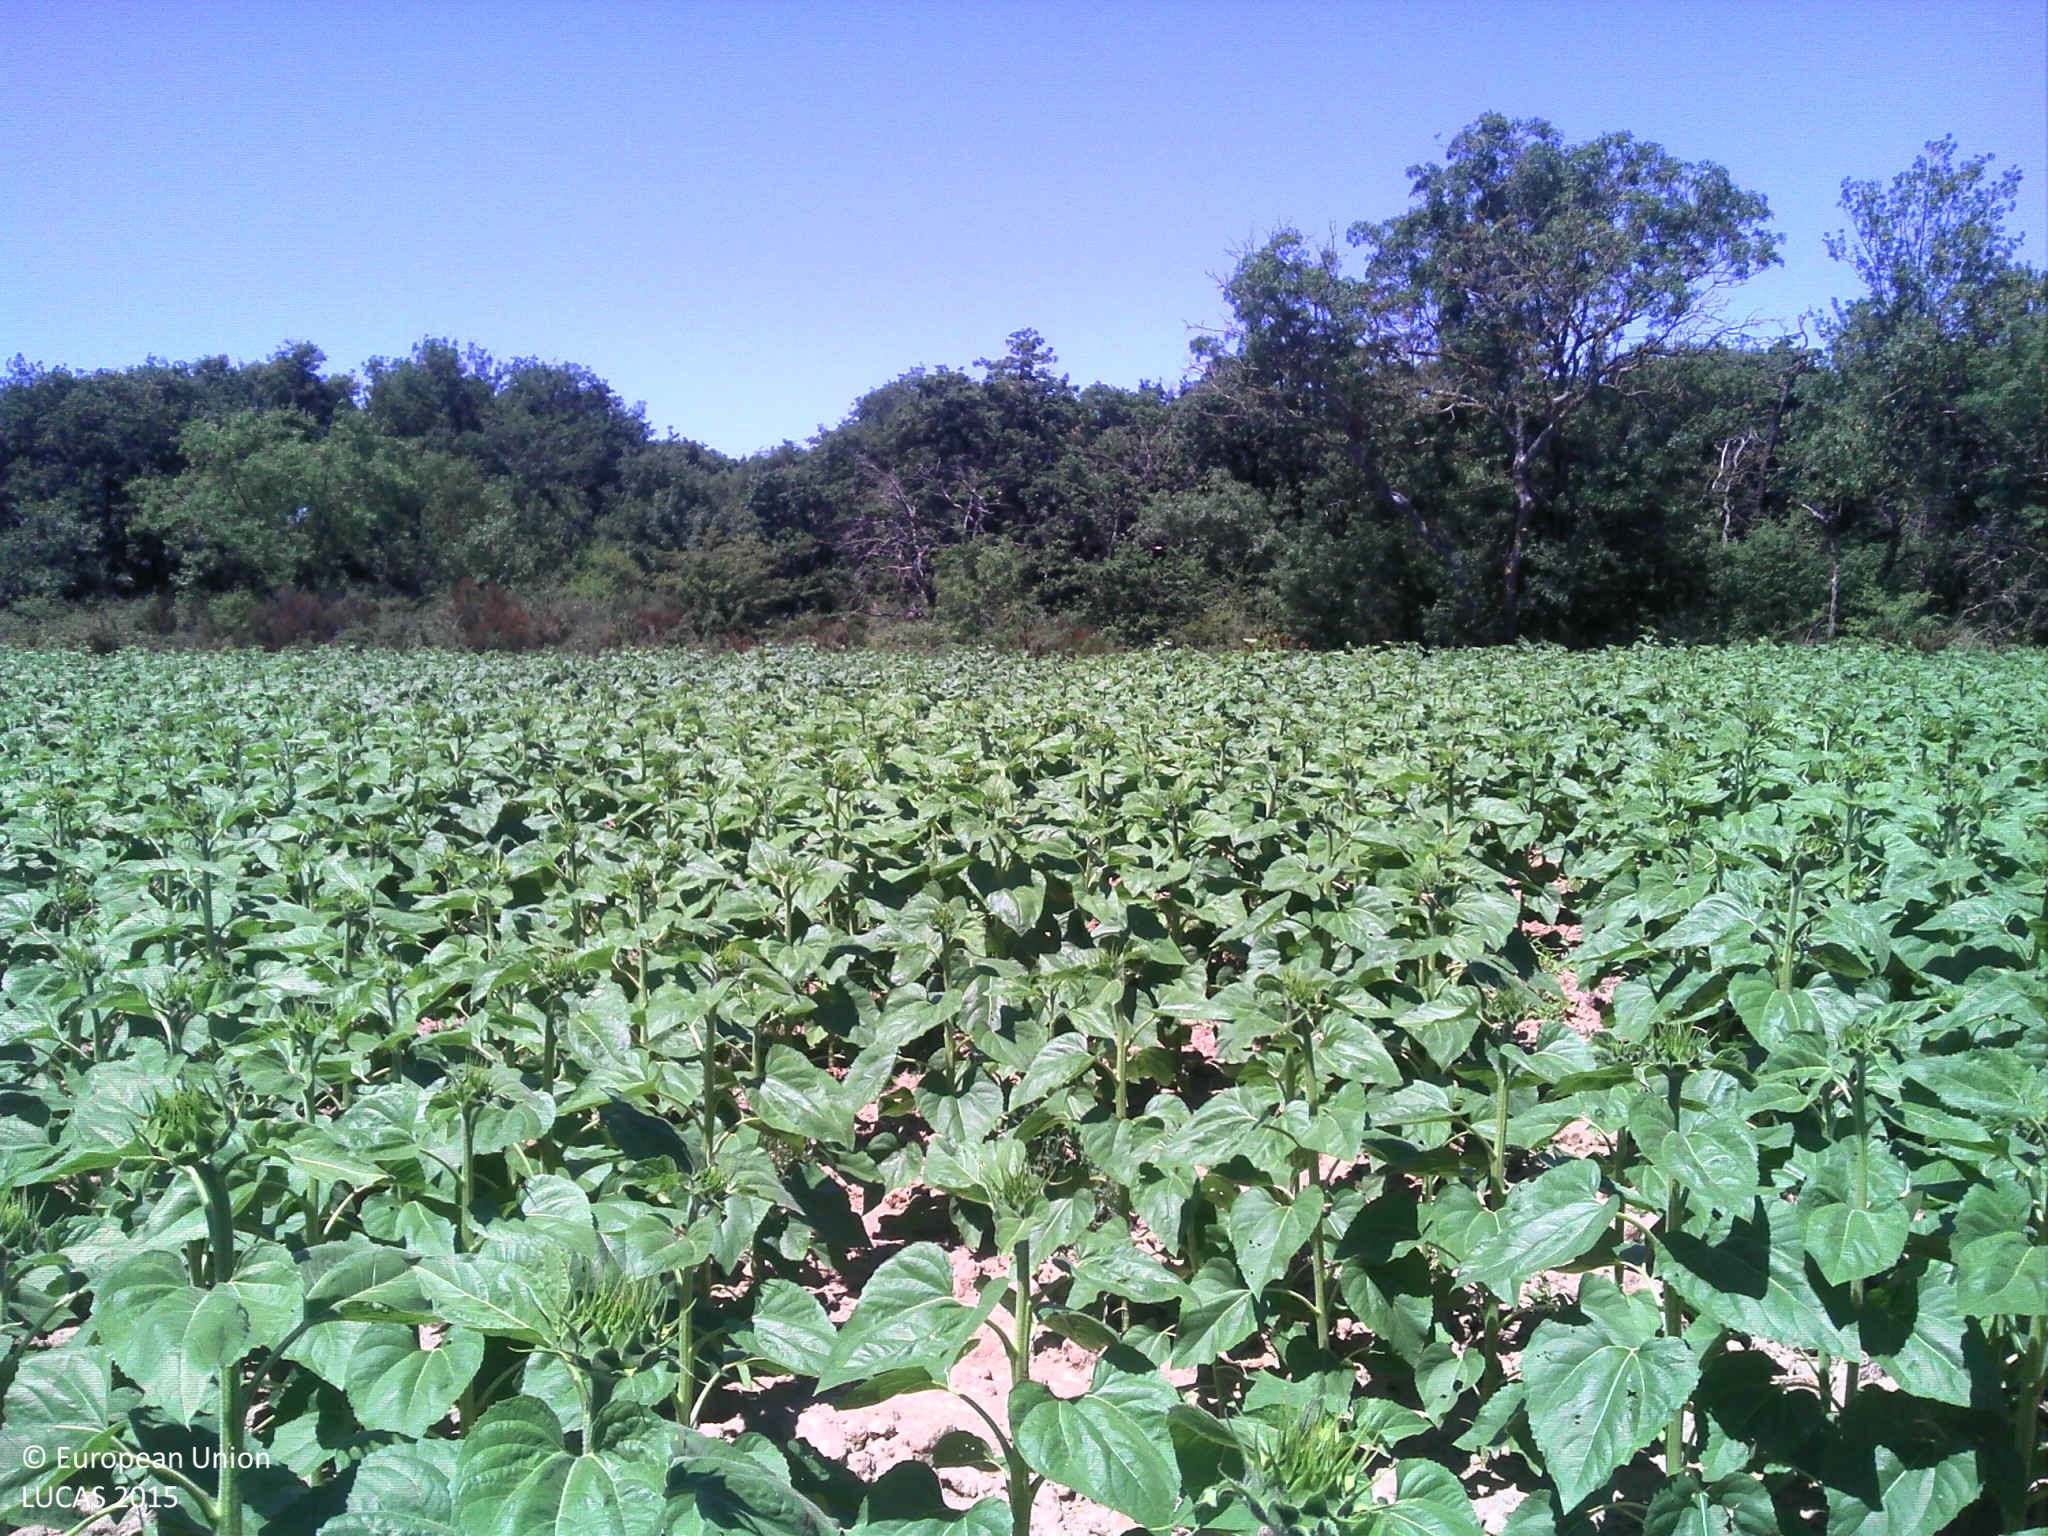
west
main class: Cropland
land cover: Sunflower
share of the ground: 50 - 75 %
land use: Agriculture (excluding fallow land and kitchen gardens)
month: June
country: FR
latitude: 43.3187
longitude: 2.0286
